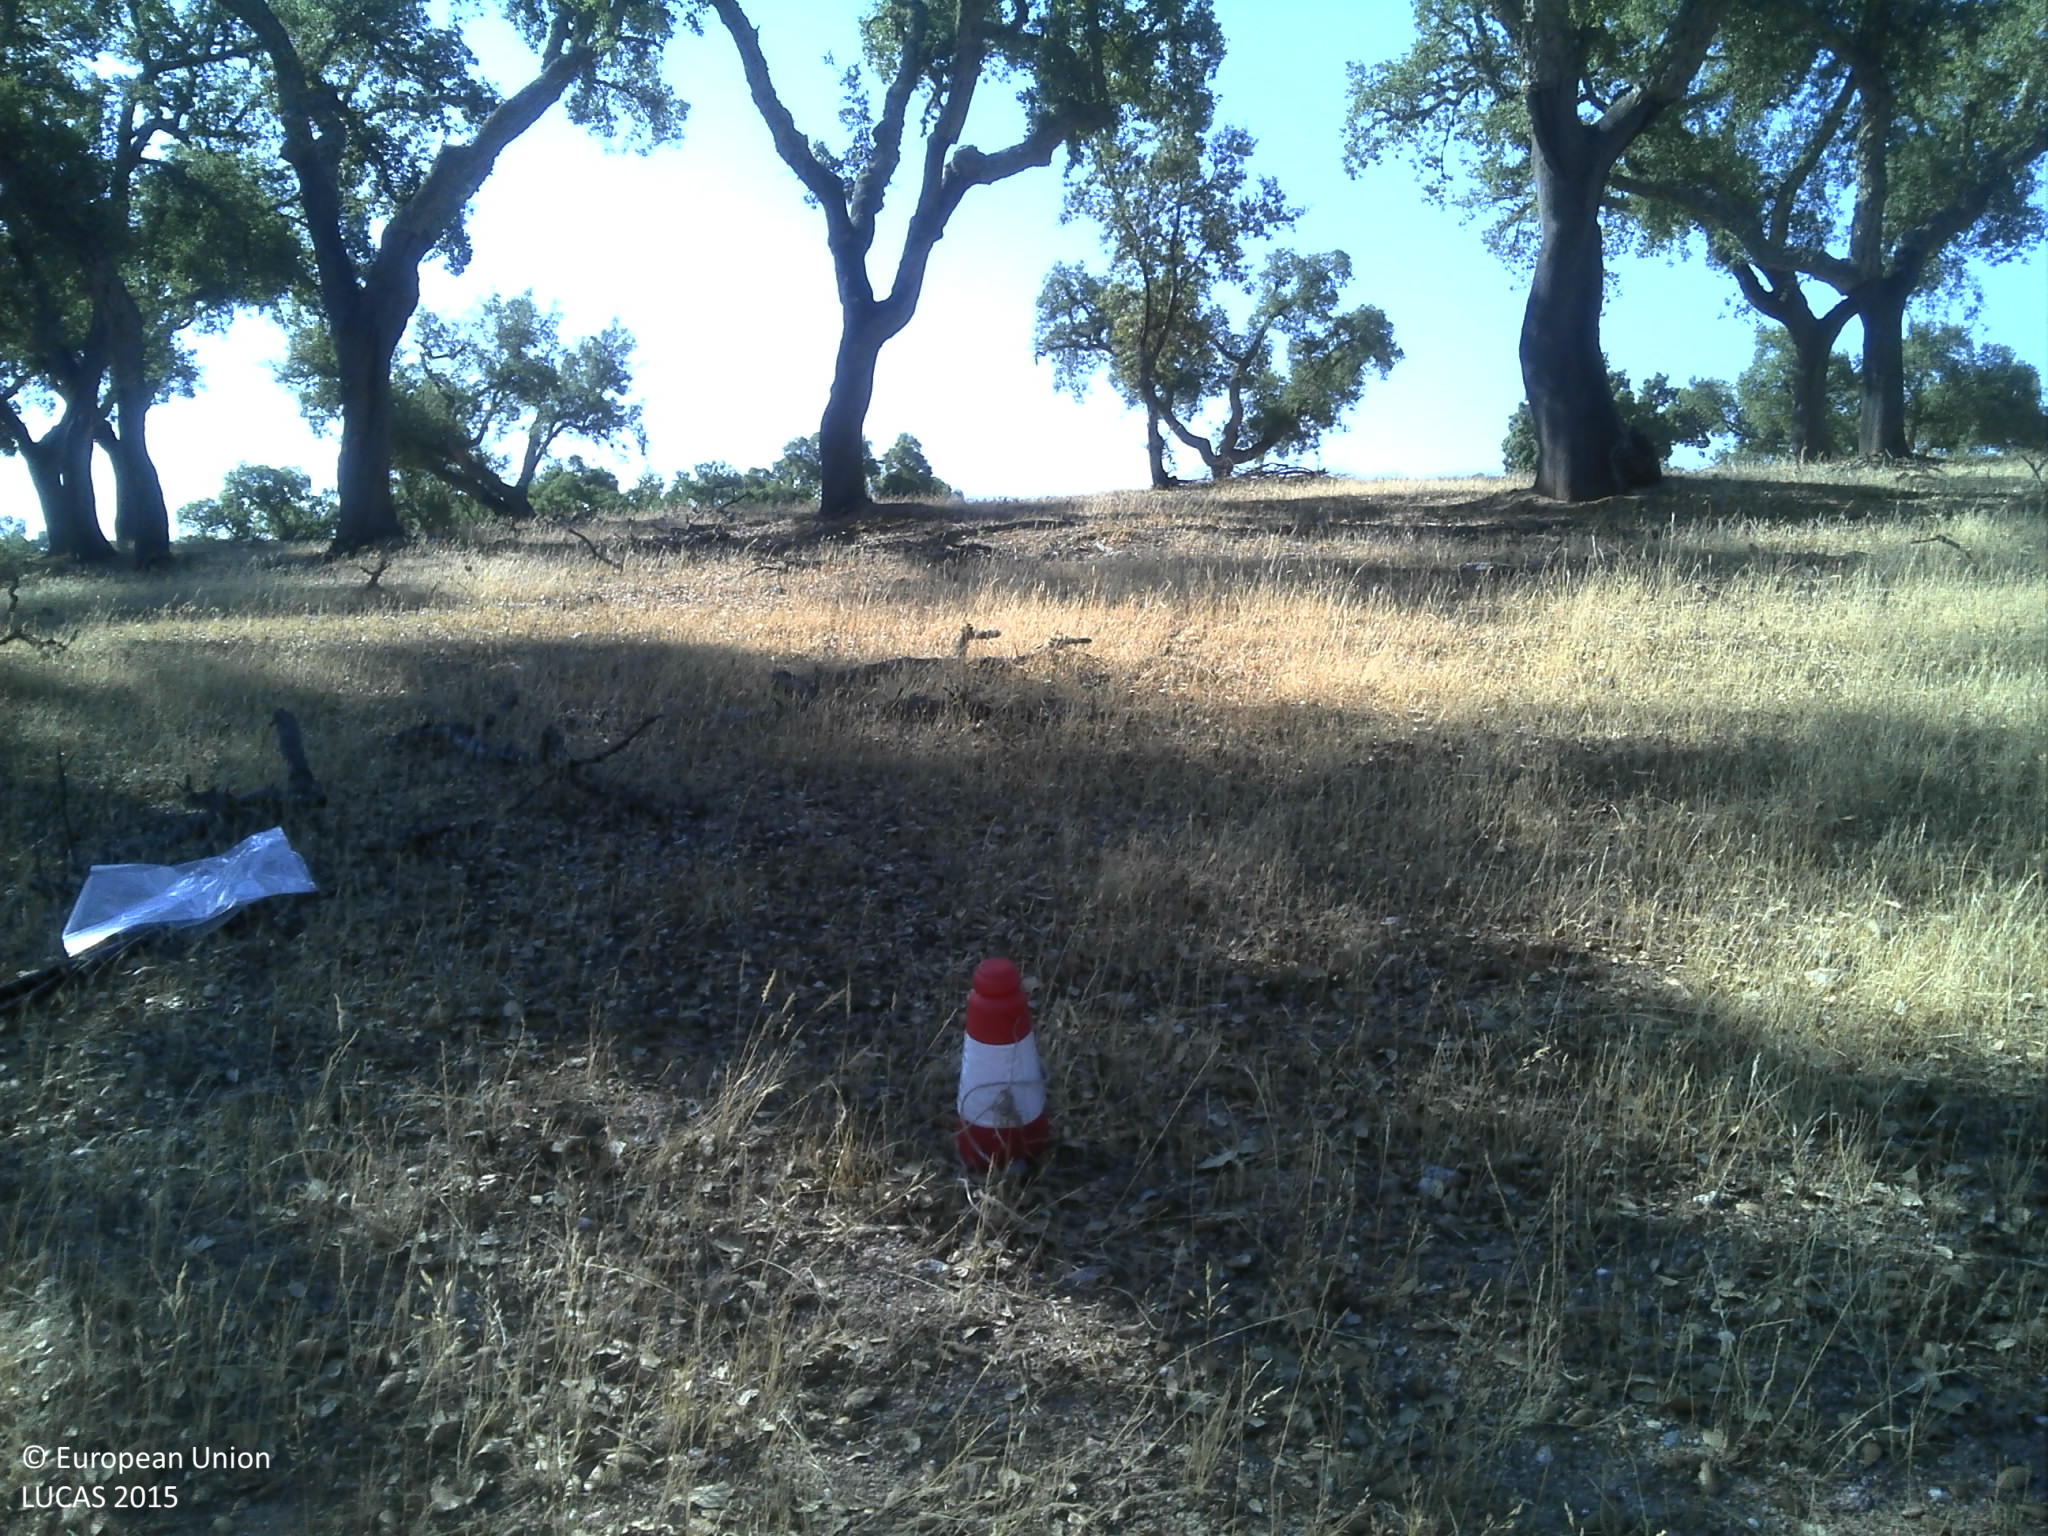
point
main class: Woodland
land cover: Broadleaved woodland
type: broadleaved evergreen forest
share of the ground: 50 - 75 %
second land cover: Grassland without tree/shrub cover
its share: 25 - 50 %
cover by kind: broadleaved forest trees 50 %, herbaceous plants 40 %, unconsolidated bare surface 10 %
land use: Forestry
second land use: Agriculture (excluding fallow land and kitchen gardens)
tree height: > 5 m
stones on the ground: 10 - 25 %
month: June
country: PT
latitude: 39.7967
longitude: -7.2487
